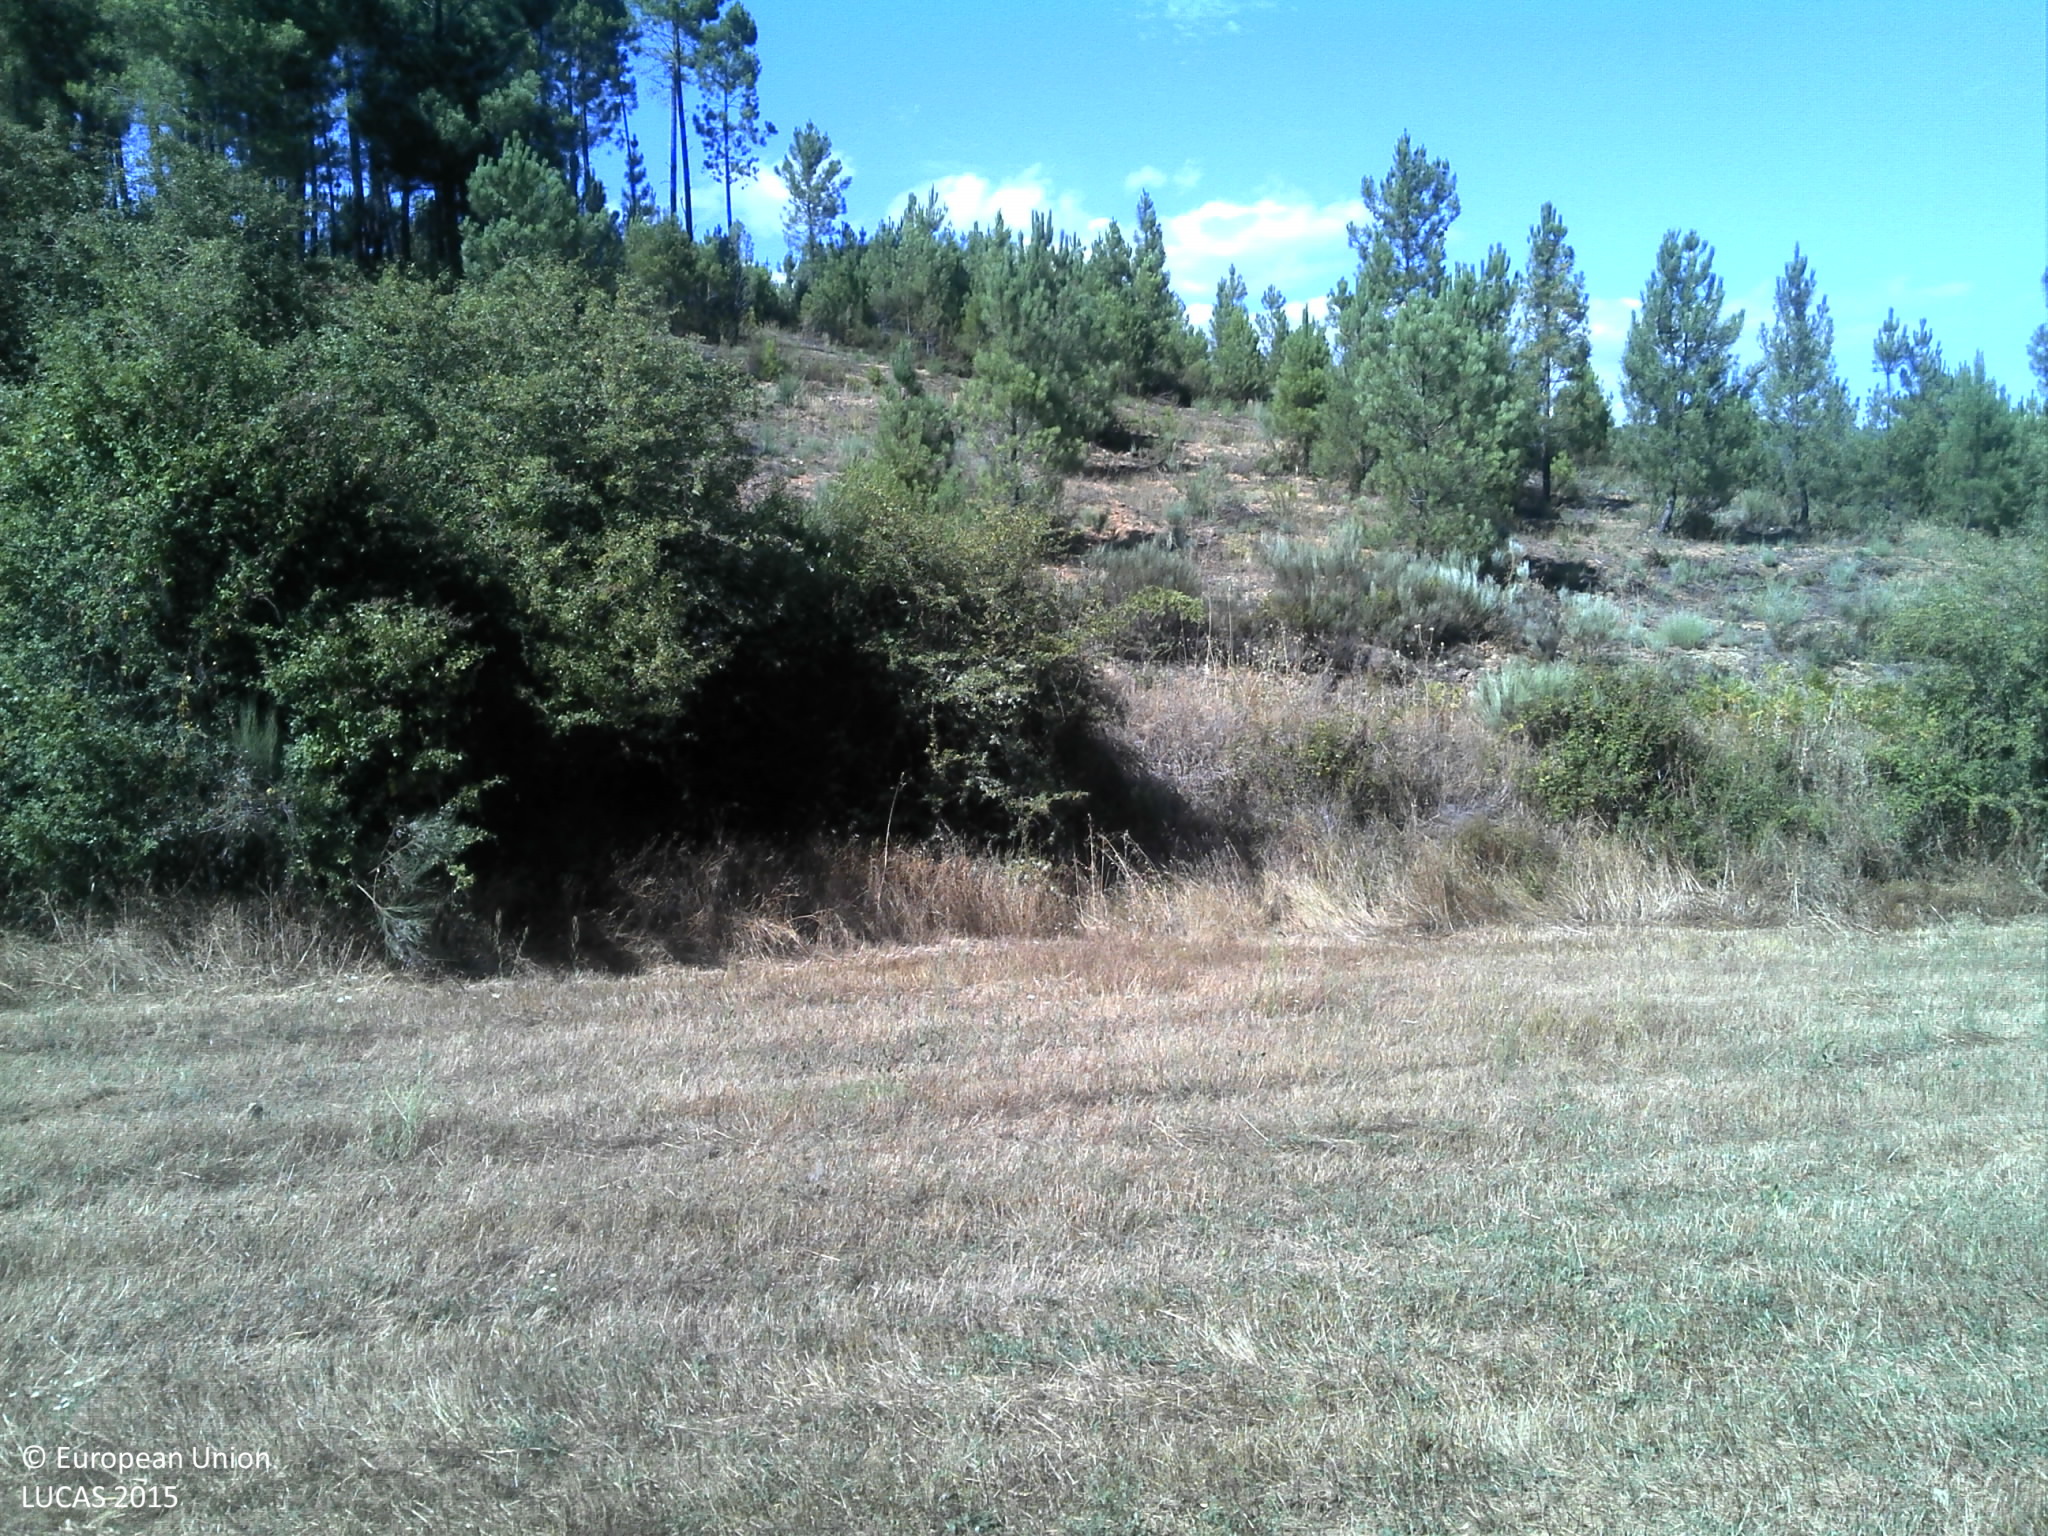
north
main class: Shrubland
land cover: Shrubland without tree cover
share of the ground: > 75 %
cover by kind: shrubs 85 %, herbaceous plants 5 %, unconsolidated bare surface 5 %
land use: Abandoned areas
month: July
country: PT
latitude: 40.1863
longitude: -7.6449
